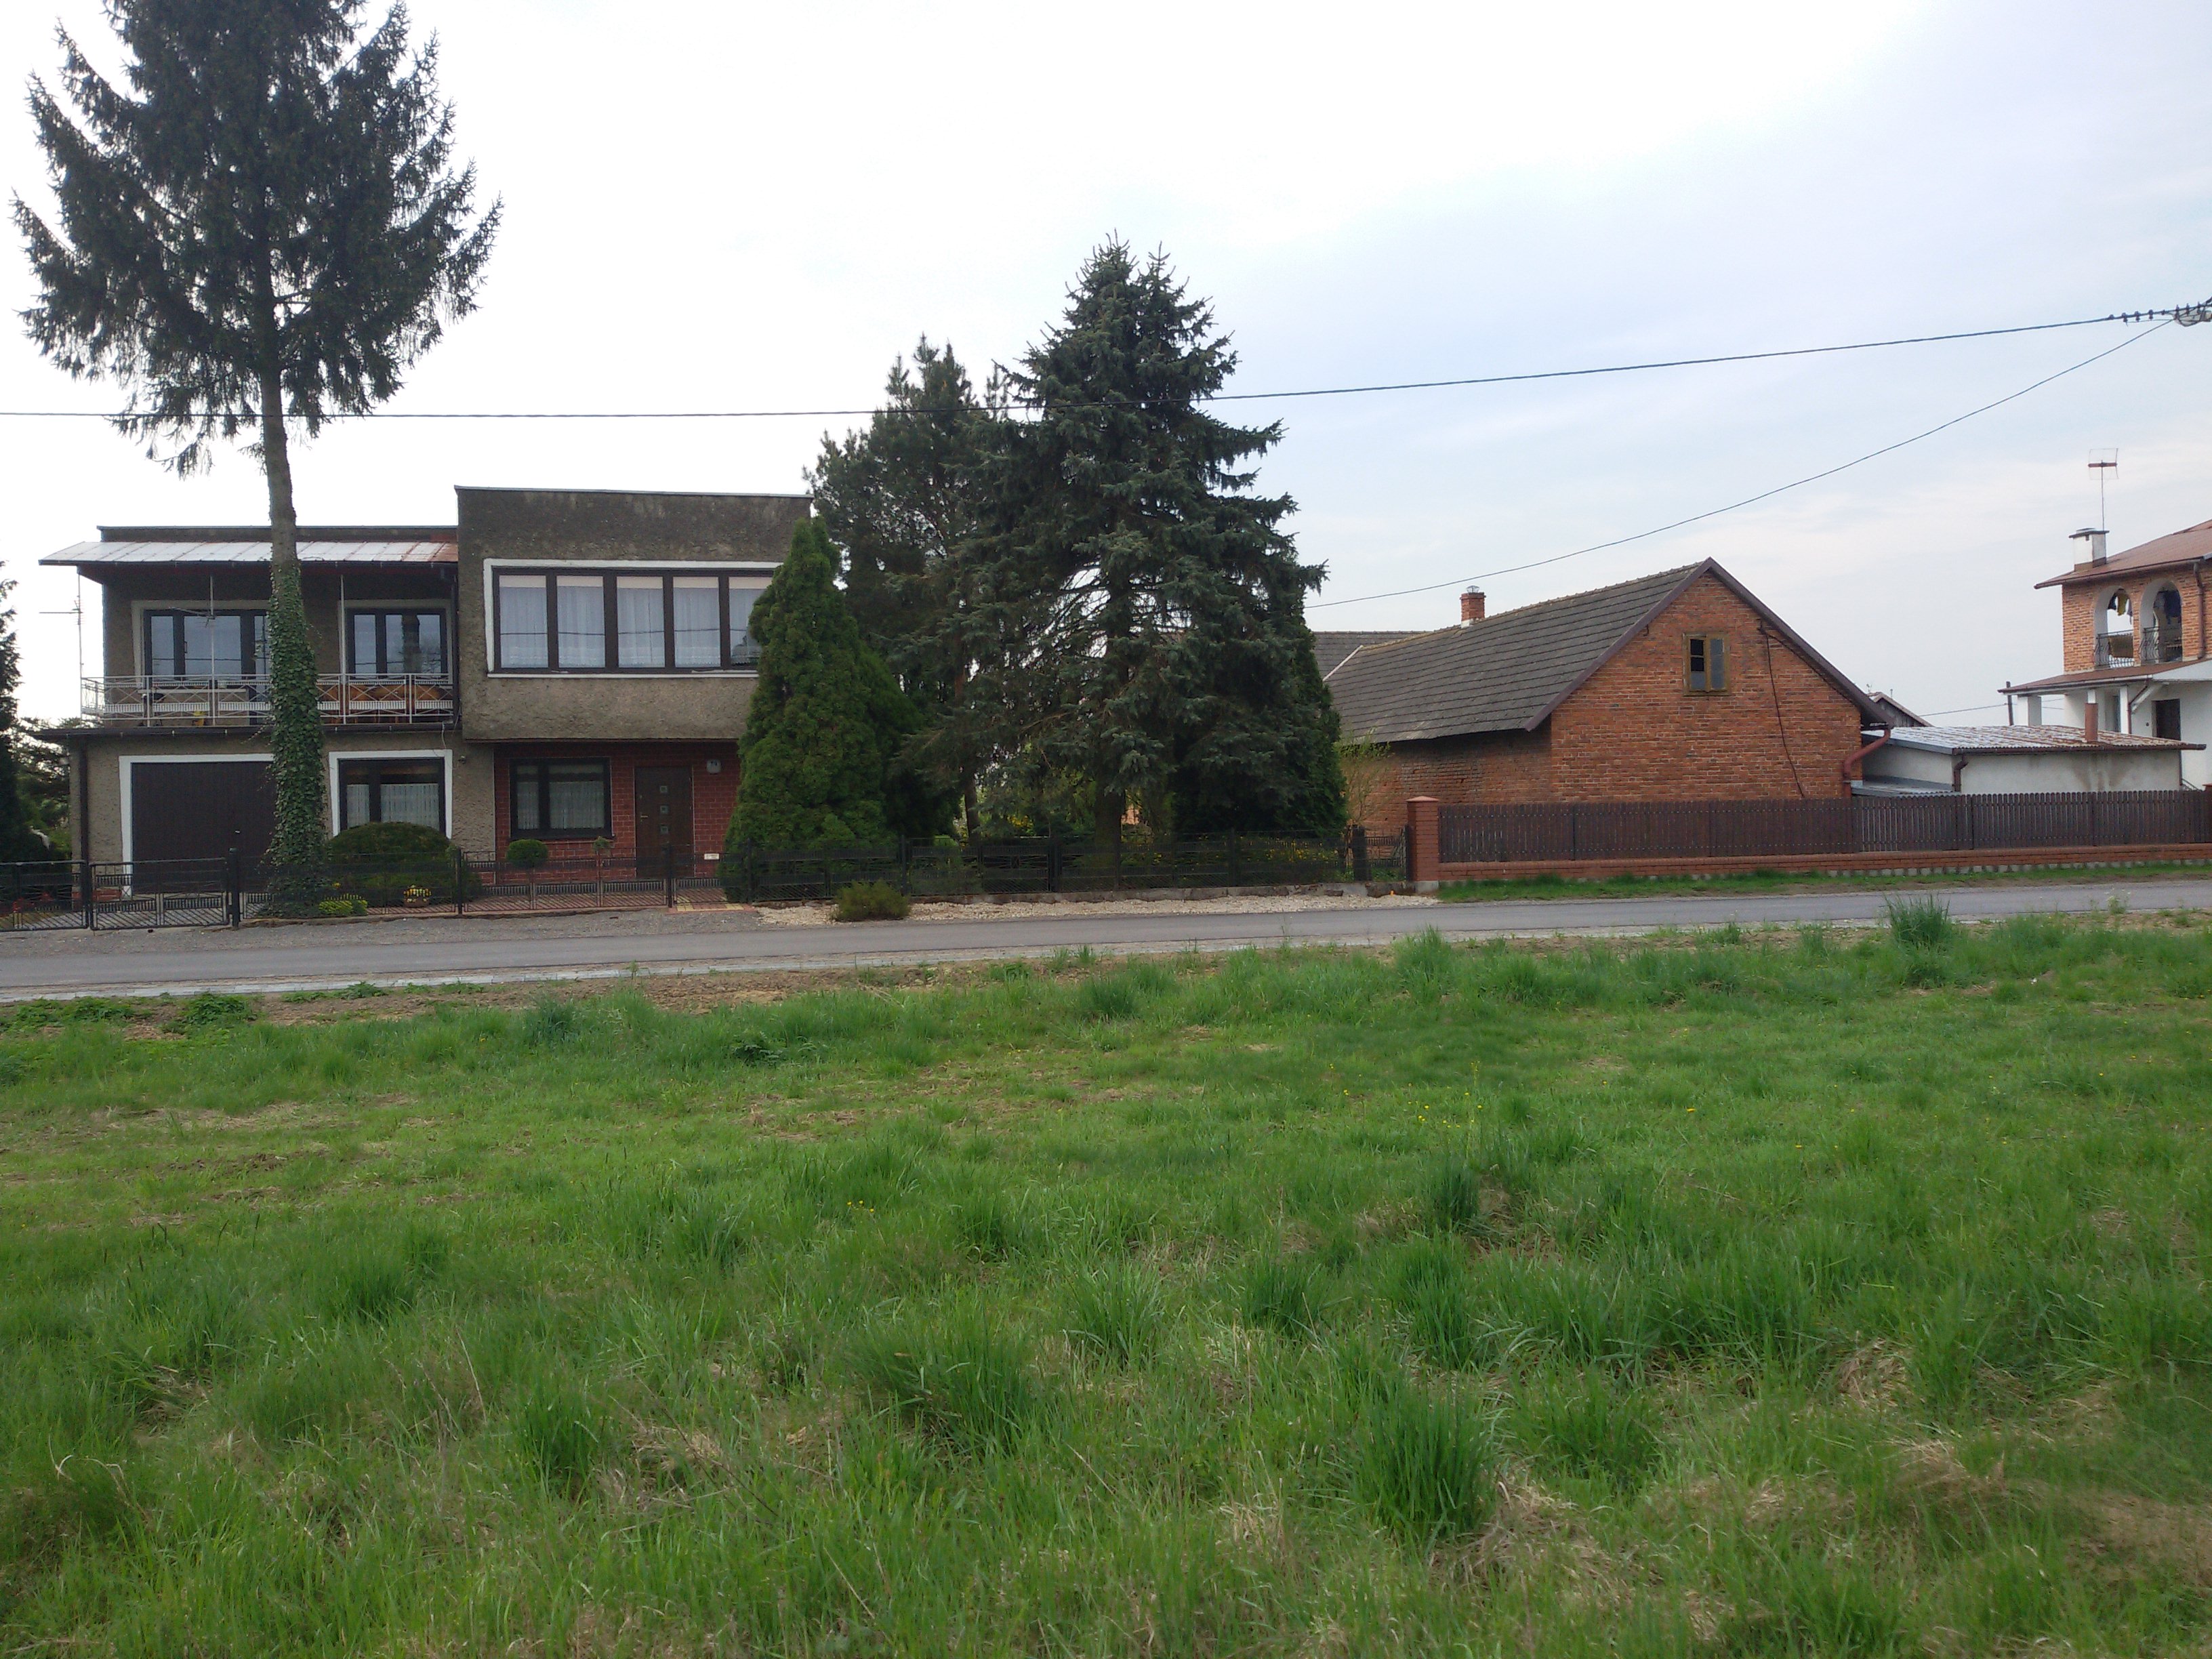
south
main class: Grassland
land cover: Grassland without tree/shrub cover
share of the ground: > 75 %
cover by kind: herbaceous plants 100 %
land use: Abandoned areas
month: May
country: PL
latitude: 50.5991
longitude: 21.6807
